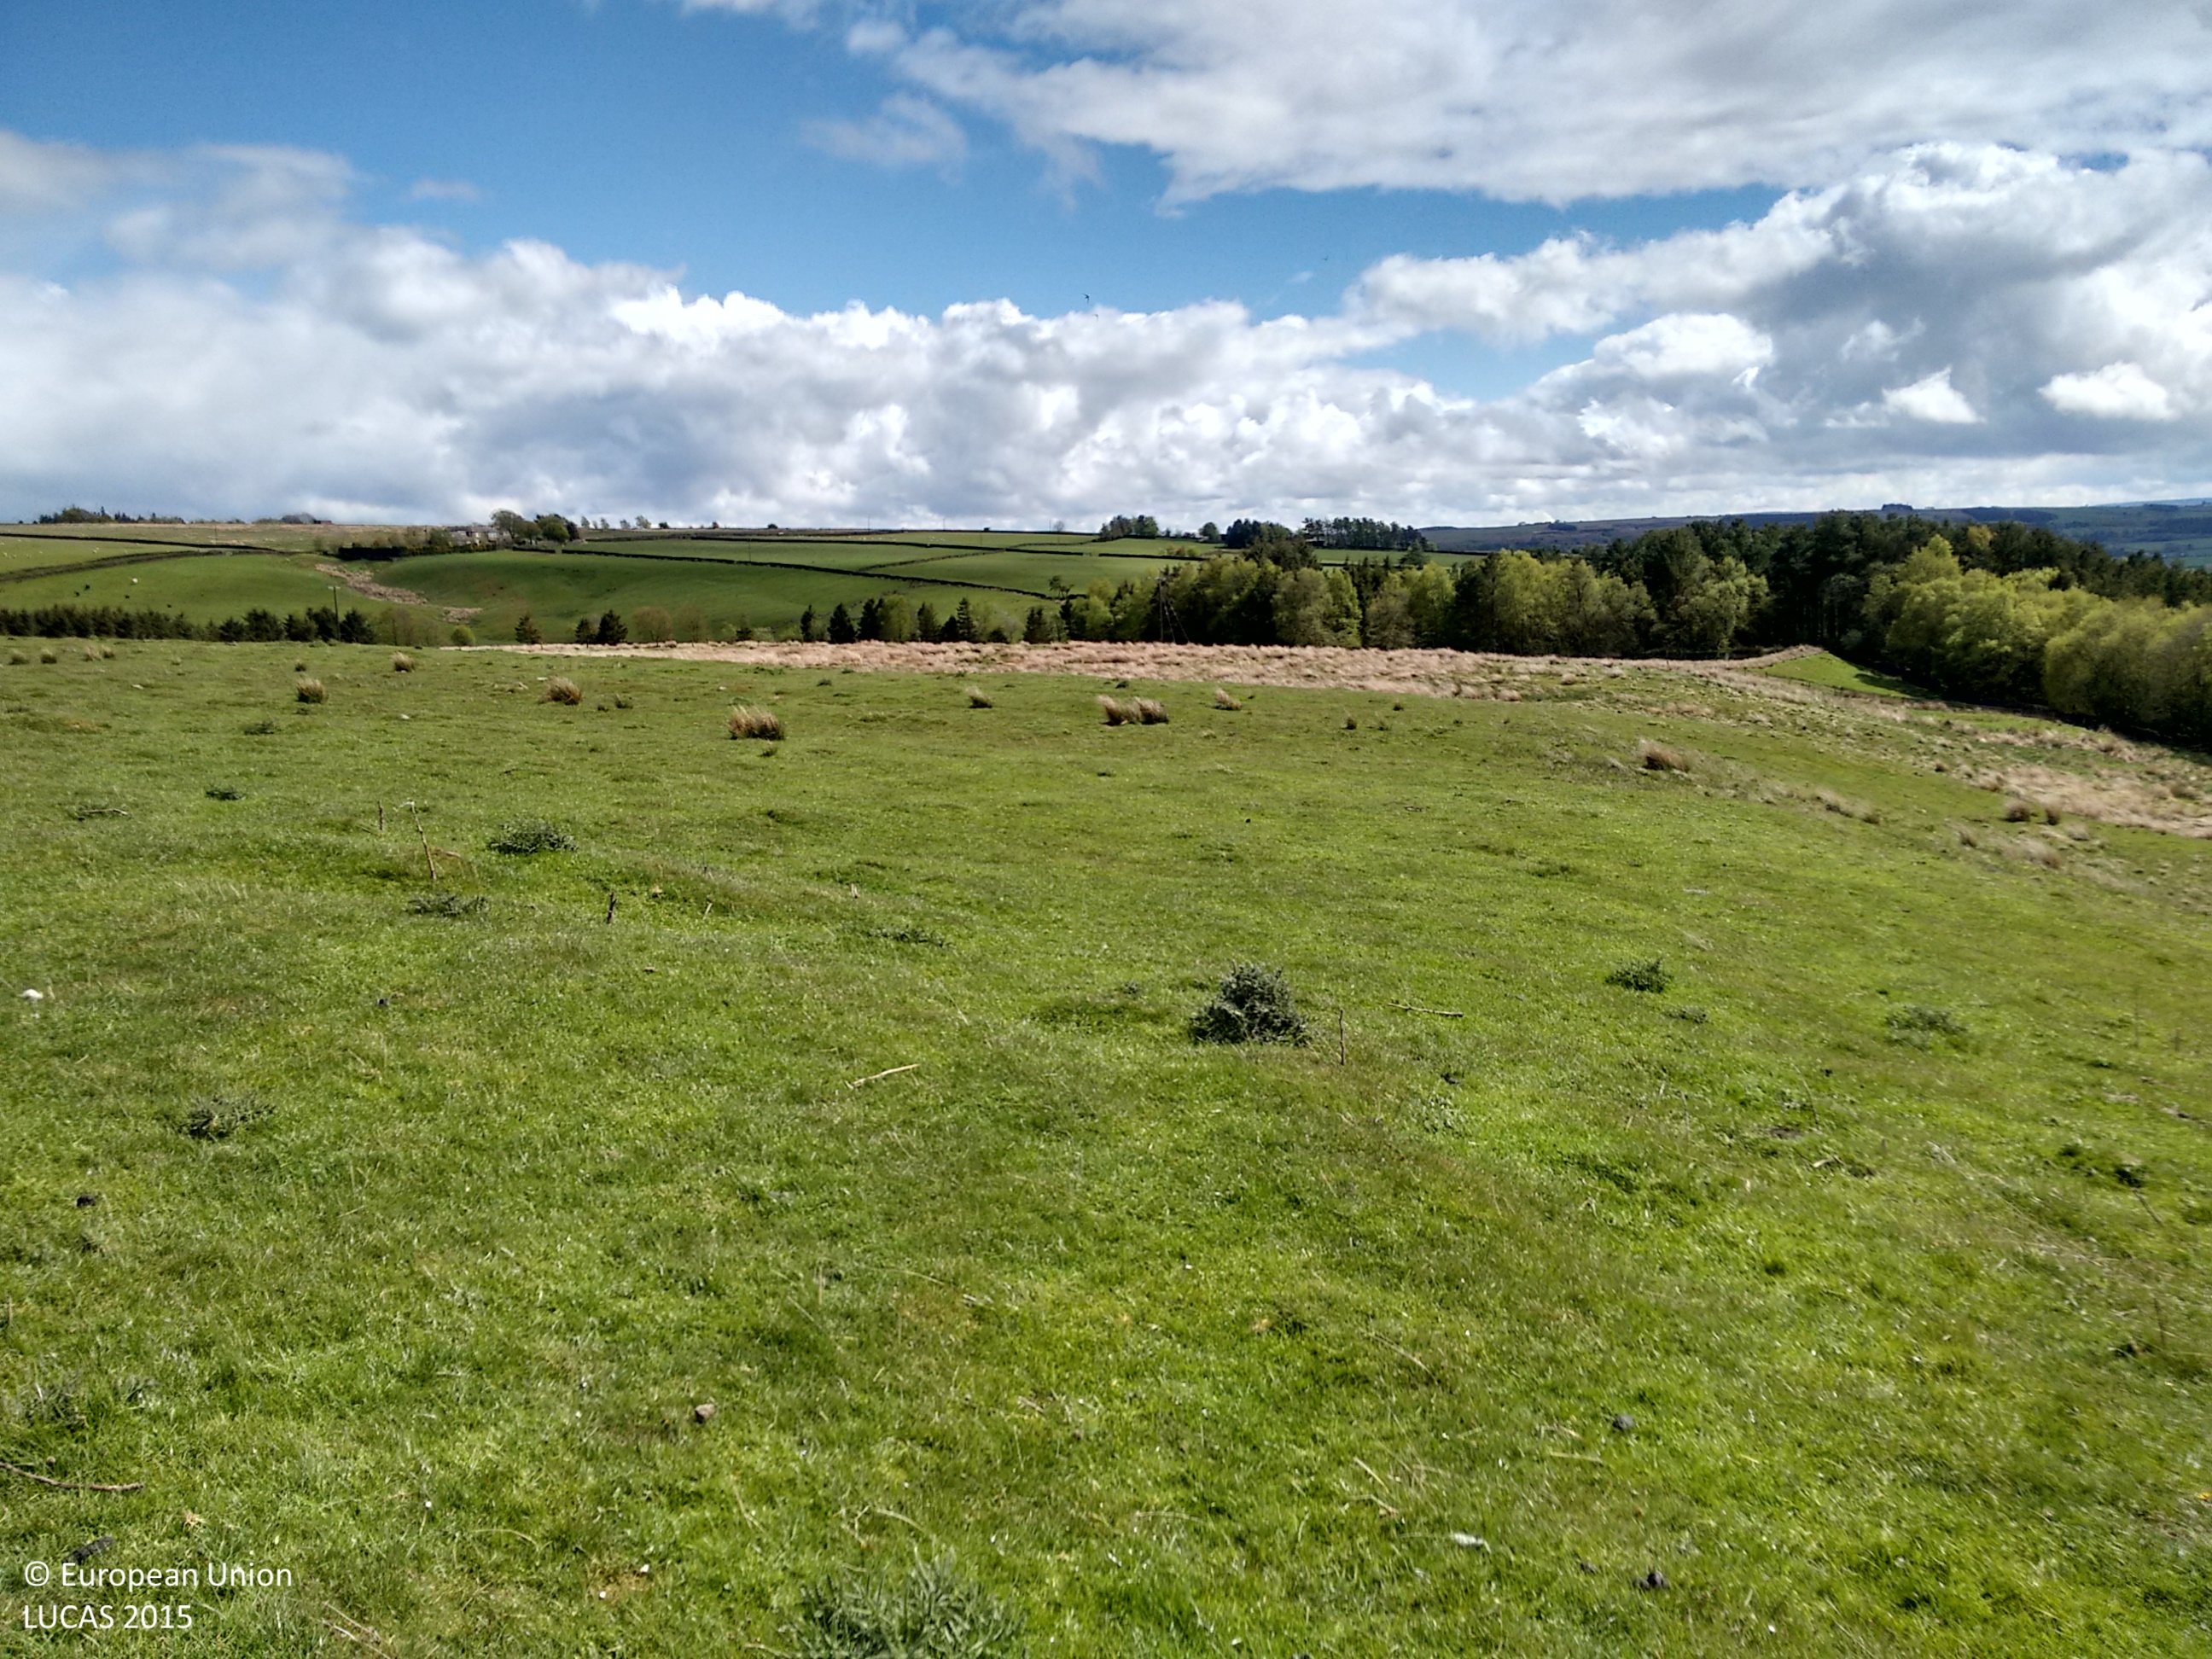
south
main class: Grassland
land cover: Grassland without tree/shrub cover
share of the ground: > 75 %
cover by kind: herbaceous plants 100 %
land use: Agriculture (excluding fallow land and kitchen gardens)
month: May
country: GB
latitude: 54.9957
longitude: -2.2668
